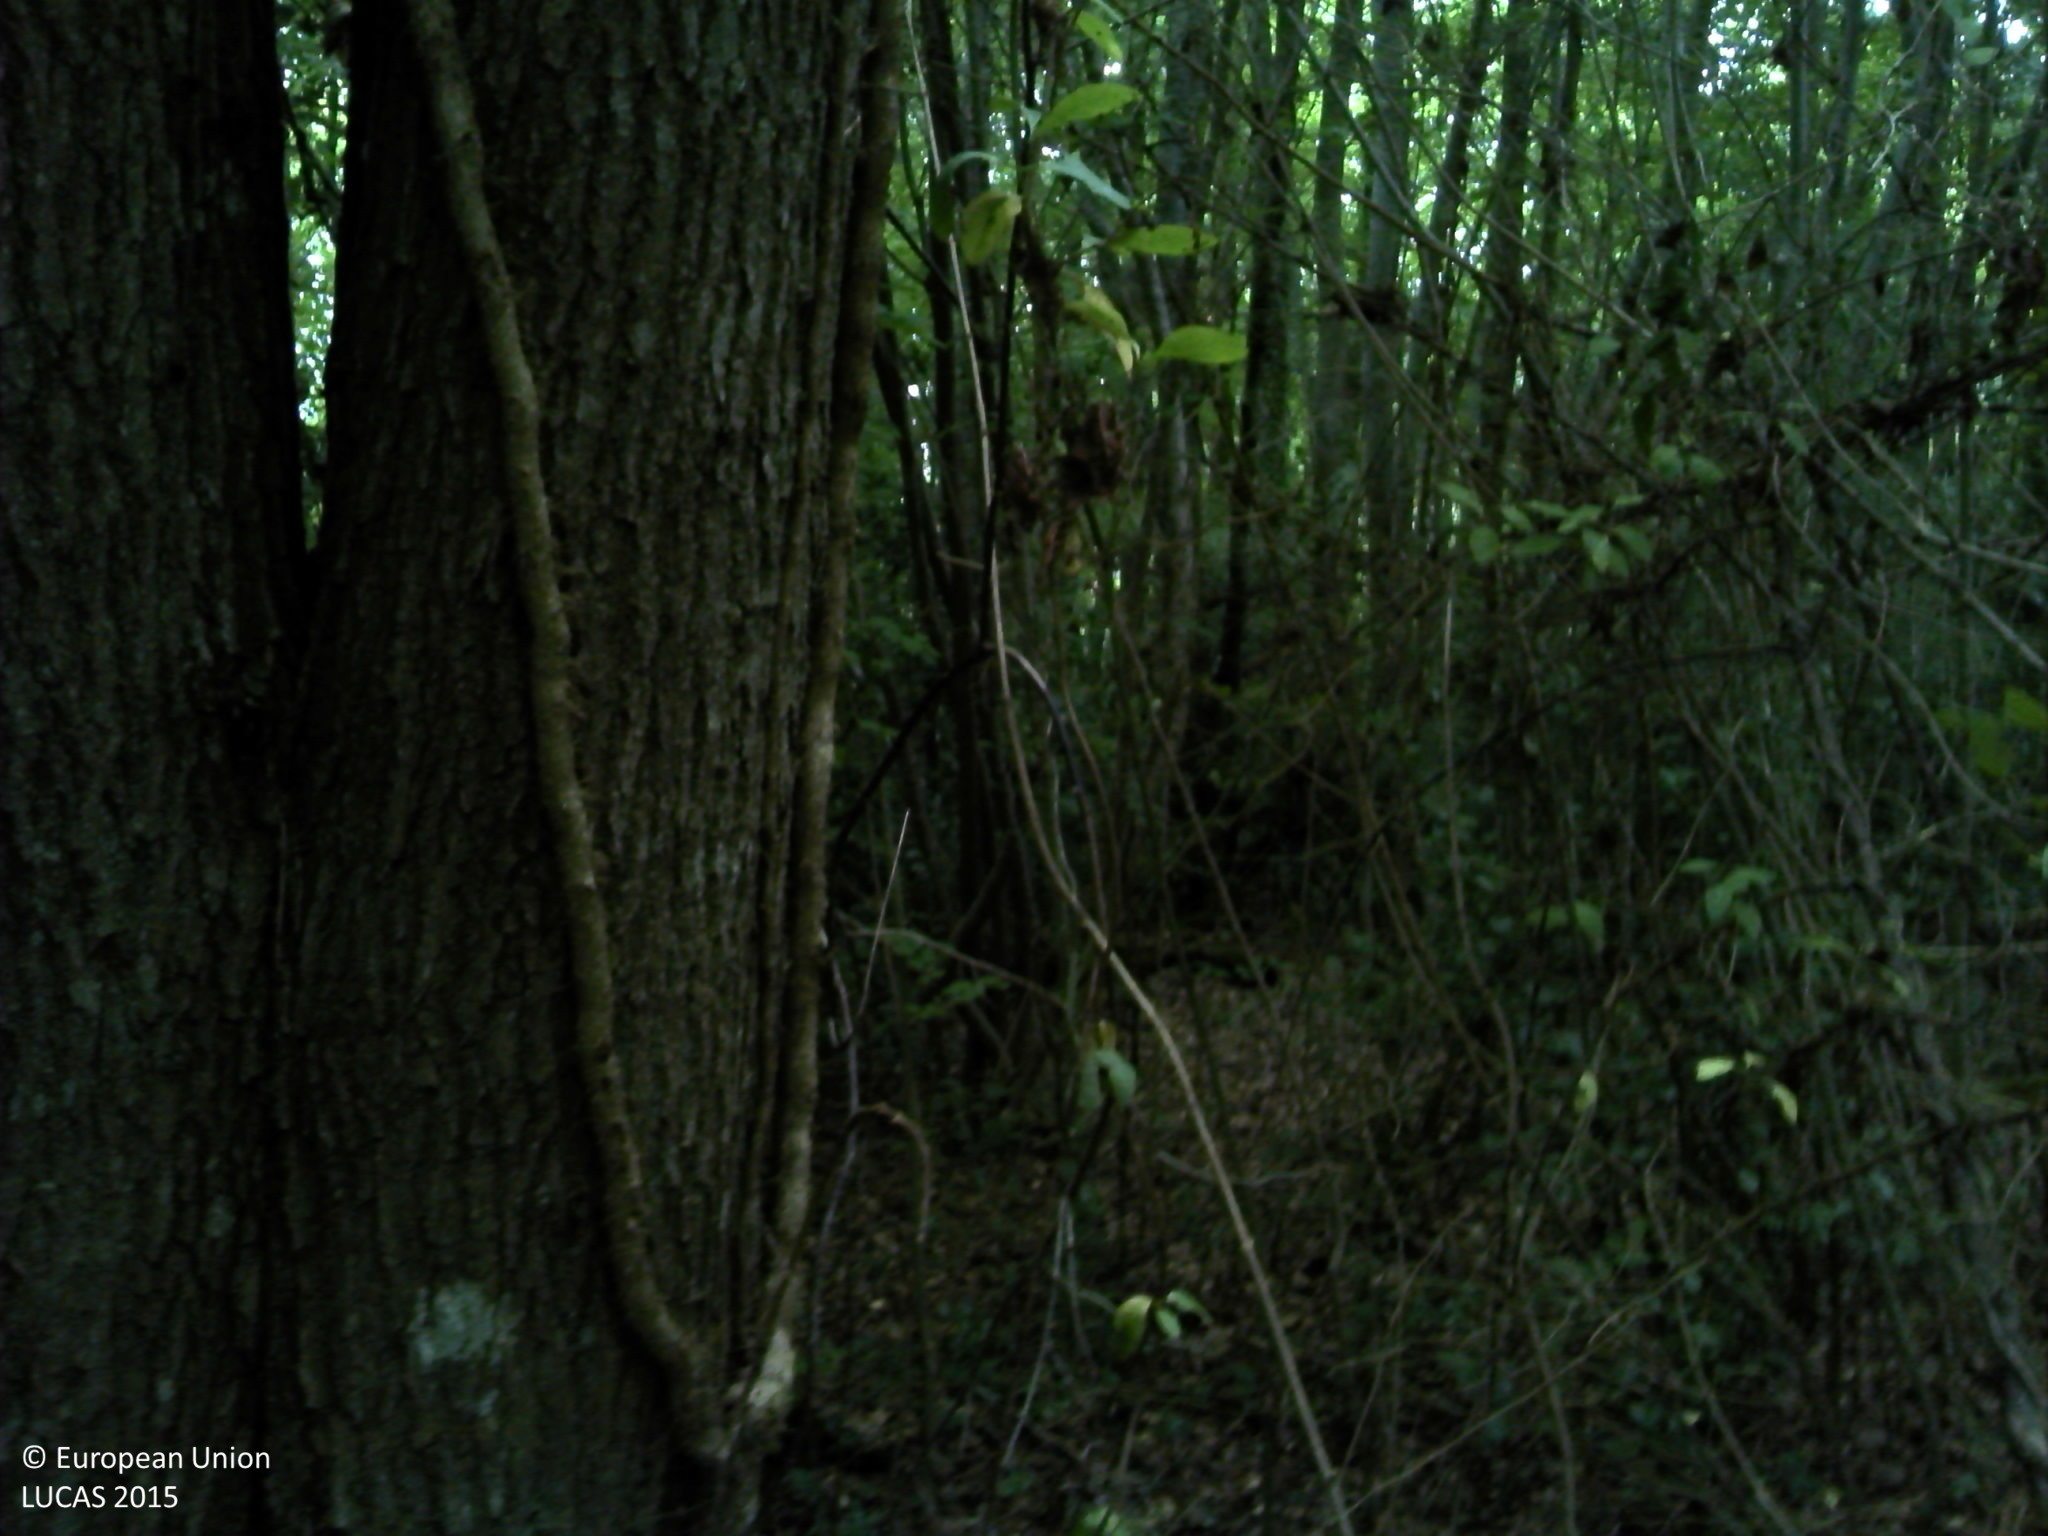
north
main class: Woodland
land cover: Broadleaved woodland
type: mesophytic deciduous forest
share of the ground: > 75 %
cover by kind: broadleaved forest trees 80 %, shrubs 15 %, herbaceous plants 5 %
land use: Semi-natural and natural areas not in use
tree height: > 5 m
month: August
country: FR
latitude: 49.0842
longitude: 0.1258
